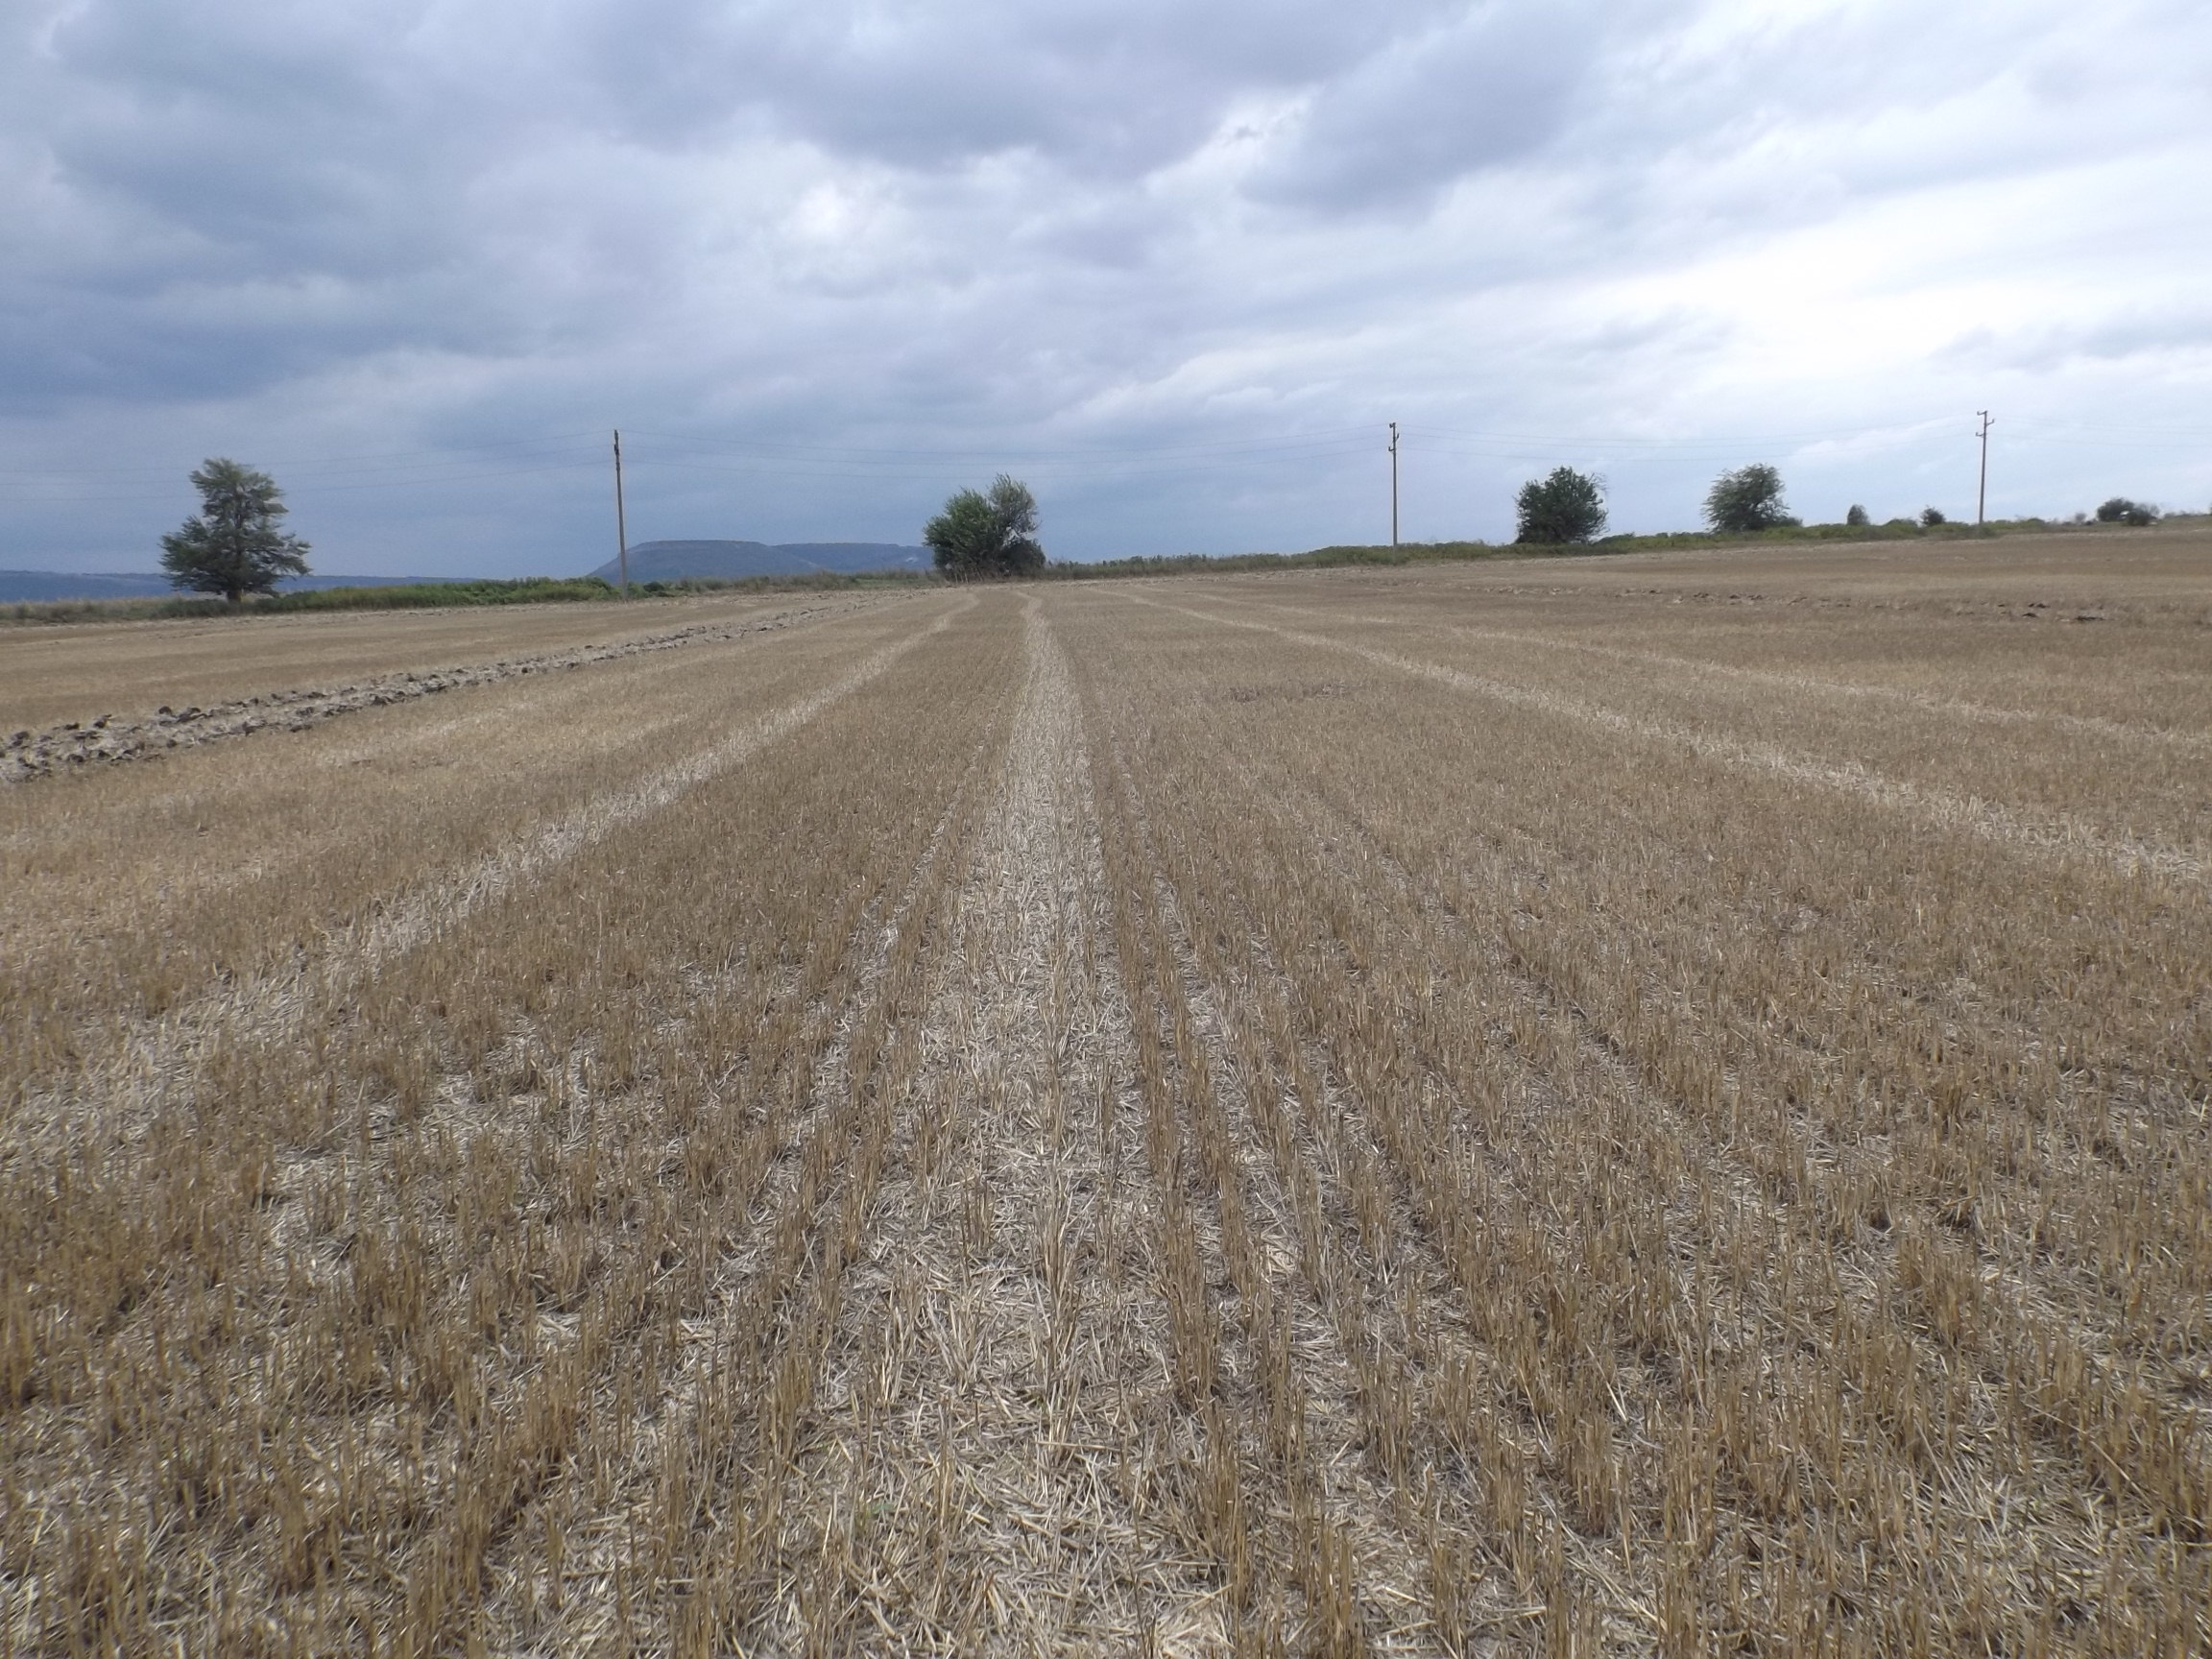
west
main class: Cropland
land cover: Common wheat
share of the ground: < 10 %
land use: Agriculture (excluding fallow land and kitchen gardens)
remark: Harvested field
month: August
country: BG
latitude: 43.2482
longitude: 27.4305
